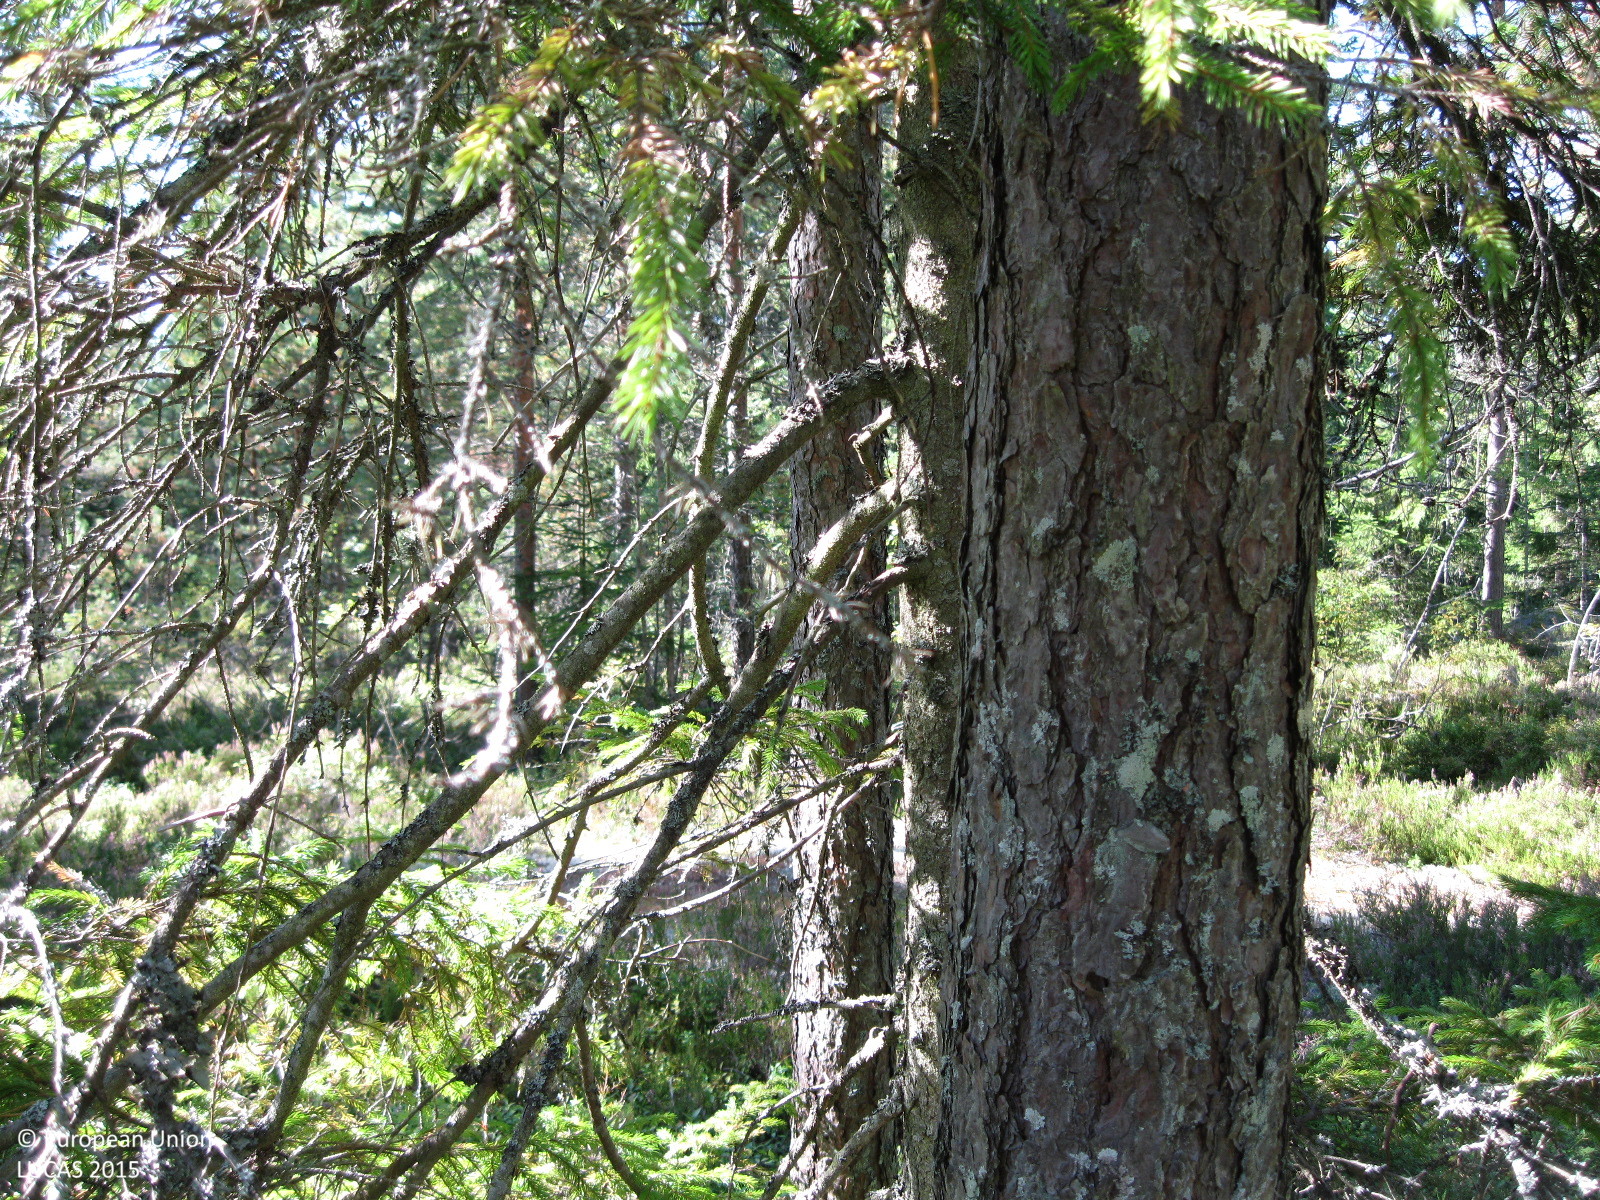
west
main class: Woodland
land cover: Pine dominated coniferous woodland
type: boreal forest
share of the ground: 50 - 75 %
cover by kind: coniferous forest trees 65 %, shrubs 15 %, herbaceous plants 15 %, broadleaved forest trees 5 %
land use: Forestry
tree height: > 5 m
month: September
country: FI
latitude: 60.6320
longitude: 24.9026
